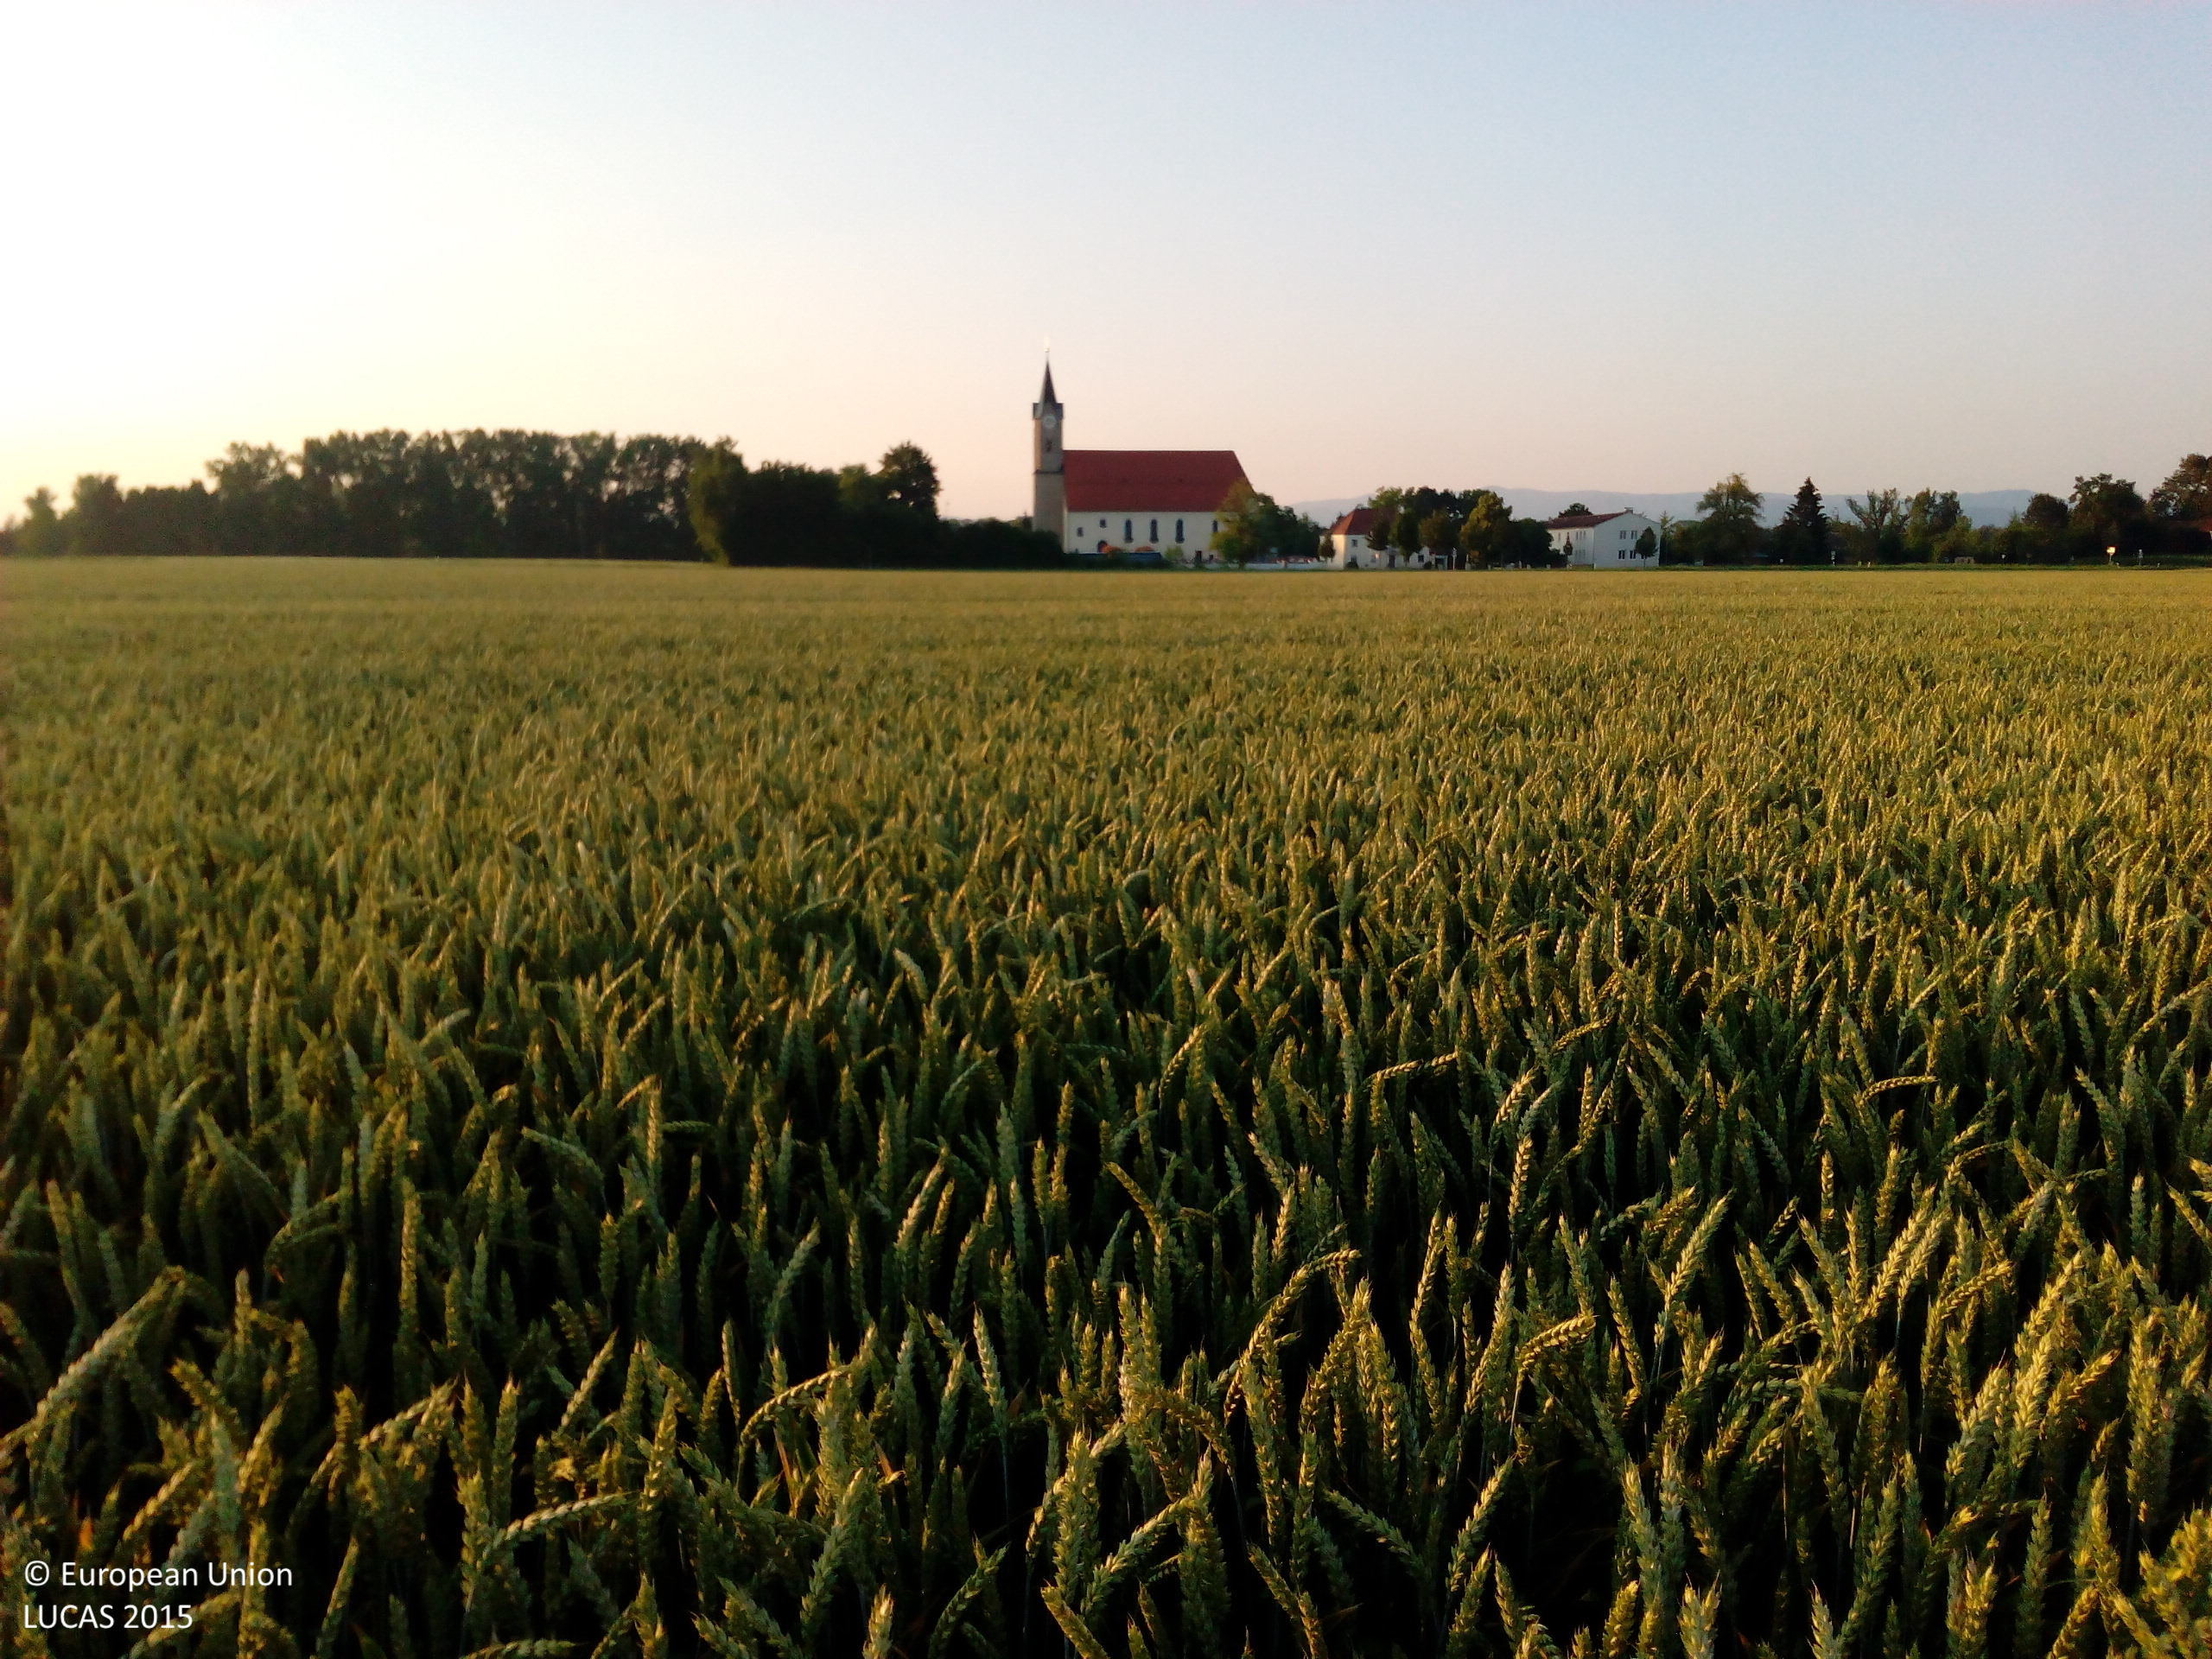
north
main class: Cropland
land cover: Common wheat
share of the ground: > 75 %
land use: Agriculture (excluding fallow land and kitchen gardens)
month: July
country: DE
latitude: 48.7422
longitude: 12.9503
